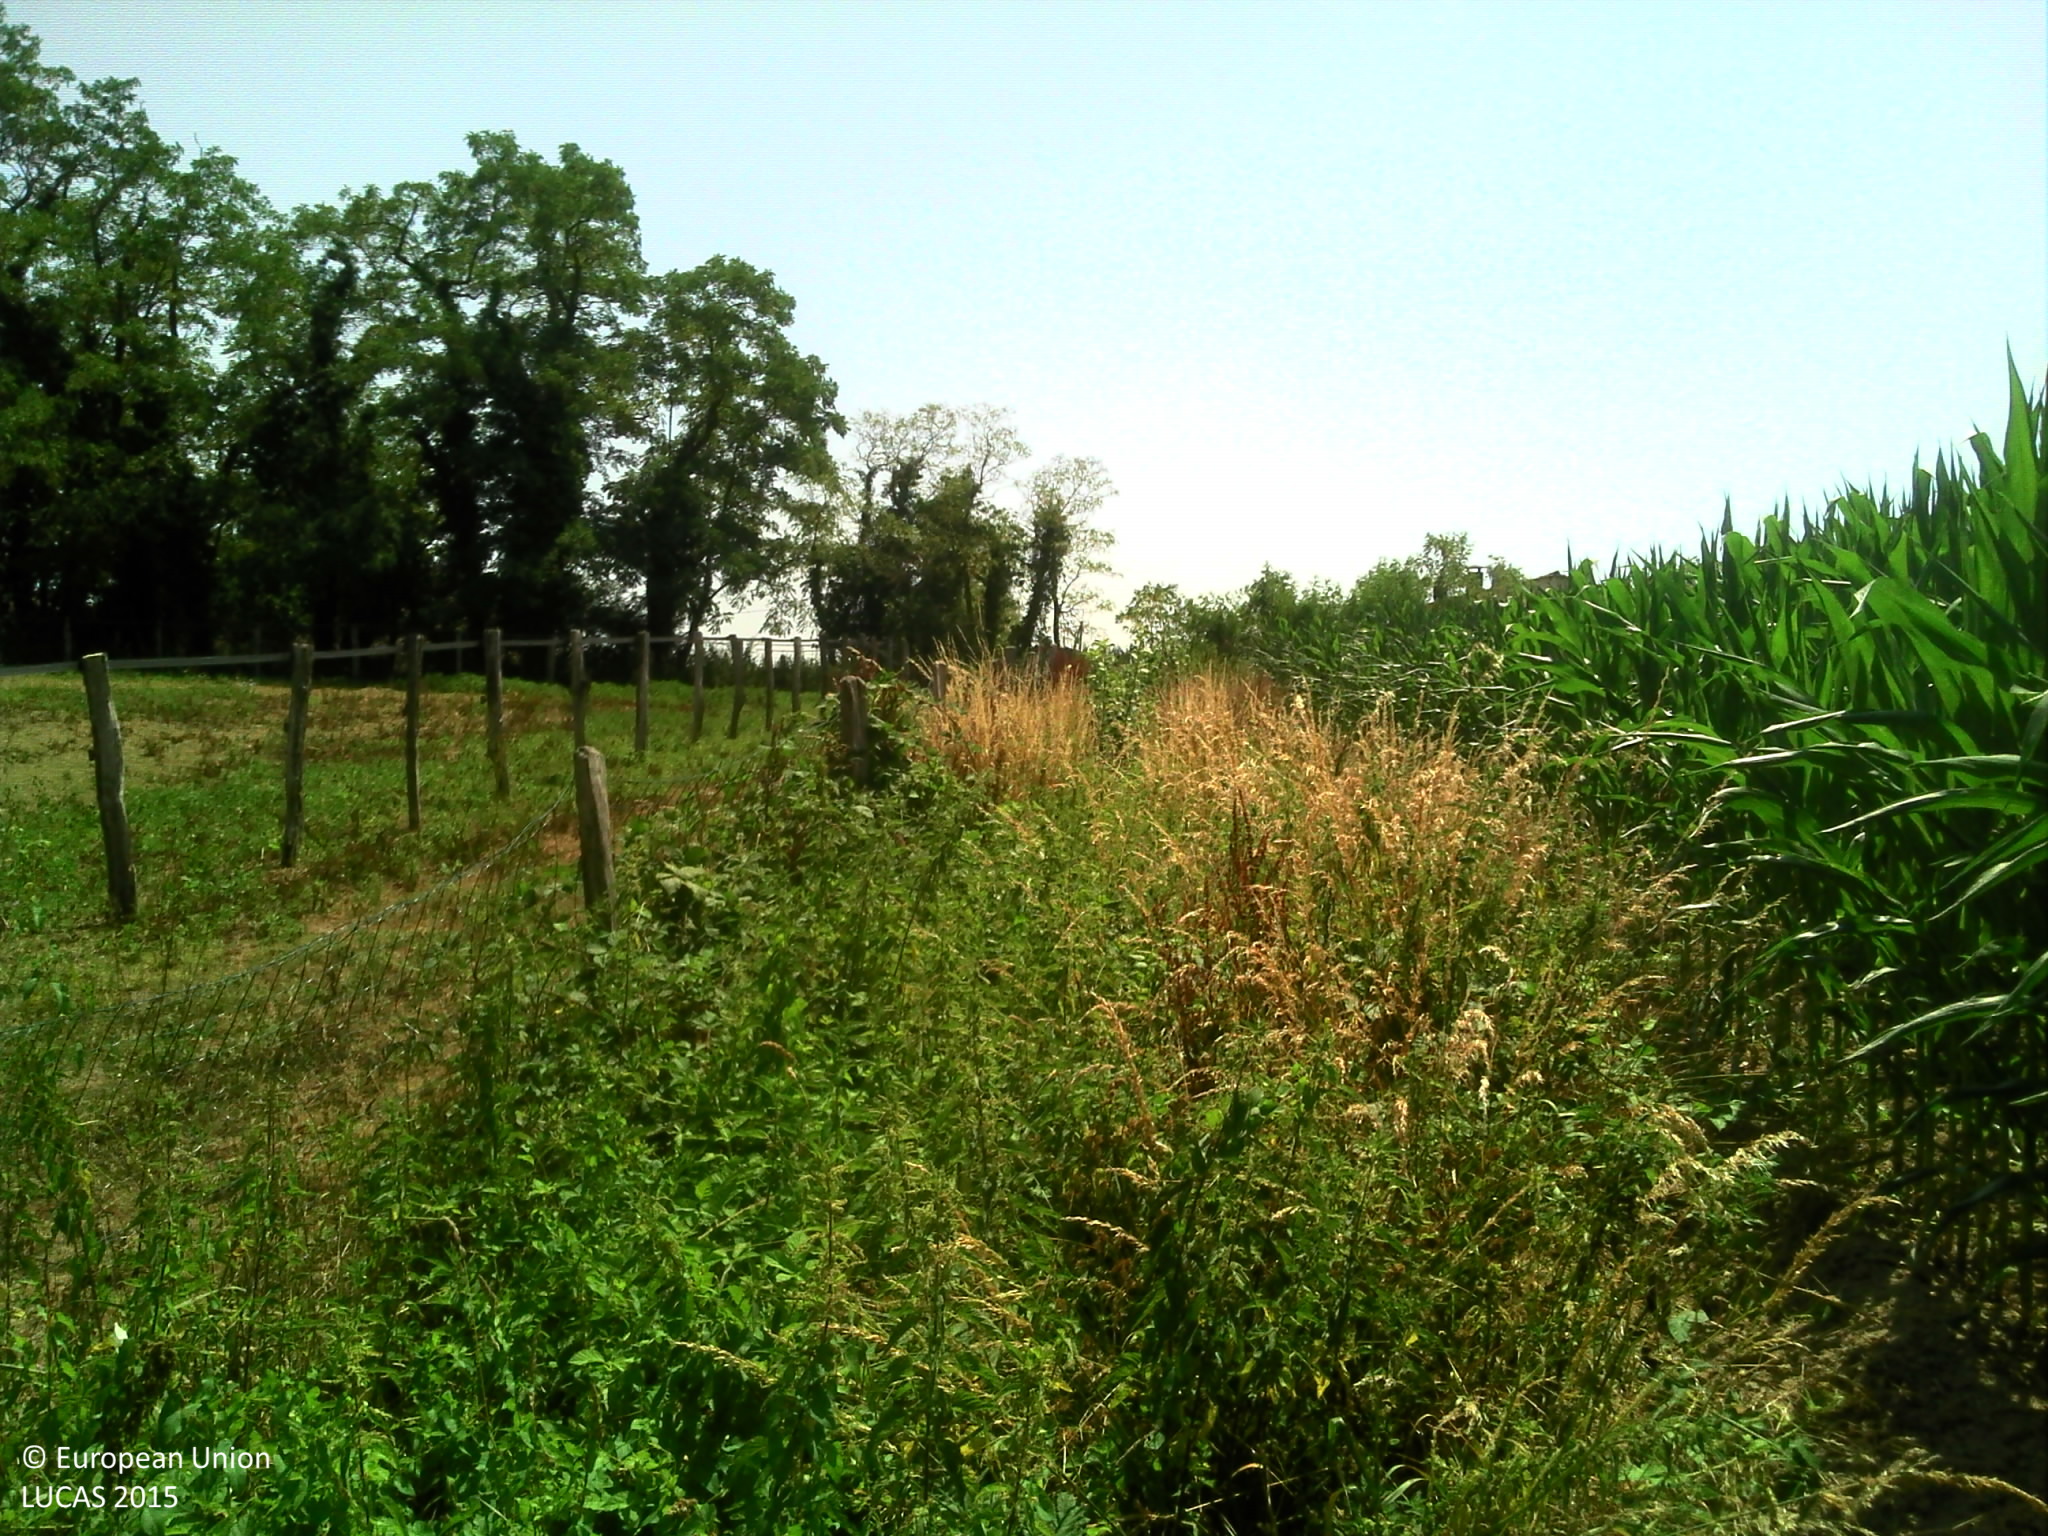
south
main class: Cropland
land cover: Maize
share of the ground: > 75 %
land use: Agriculture (excluding fallow land and kitchen gardens)
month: July
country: FR
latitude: 46.8227
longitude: 5.2436
